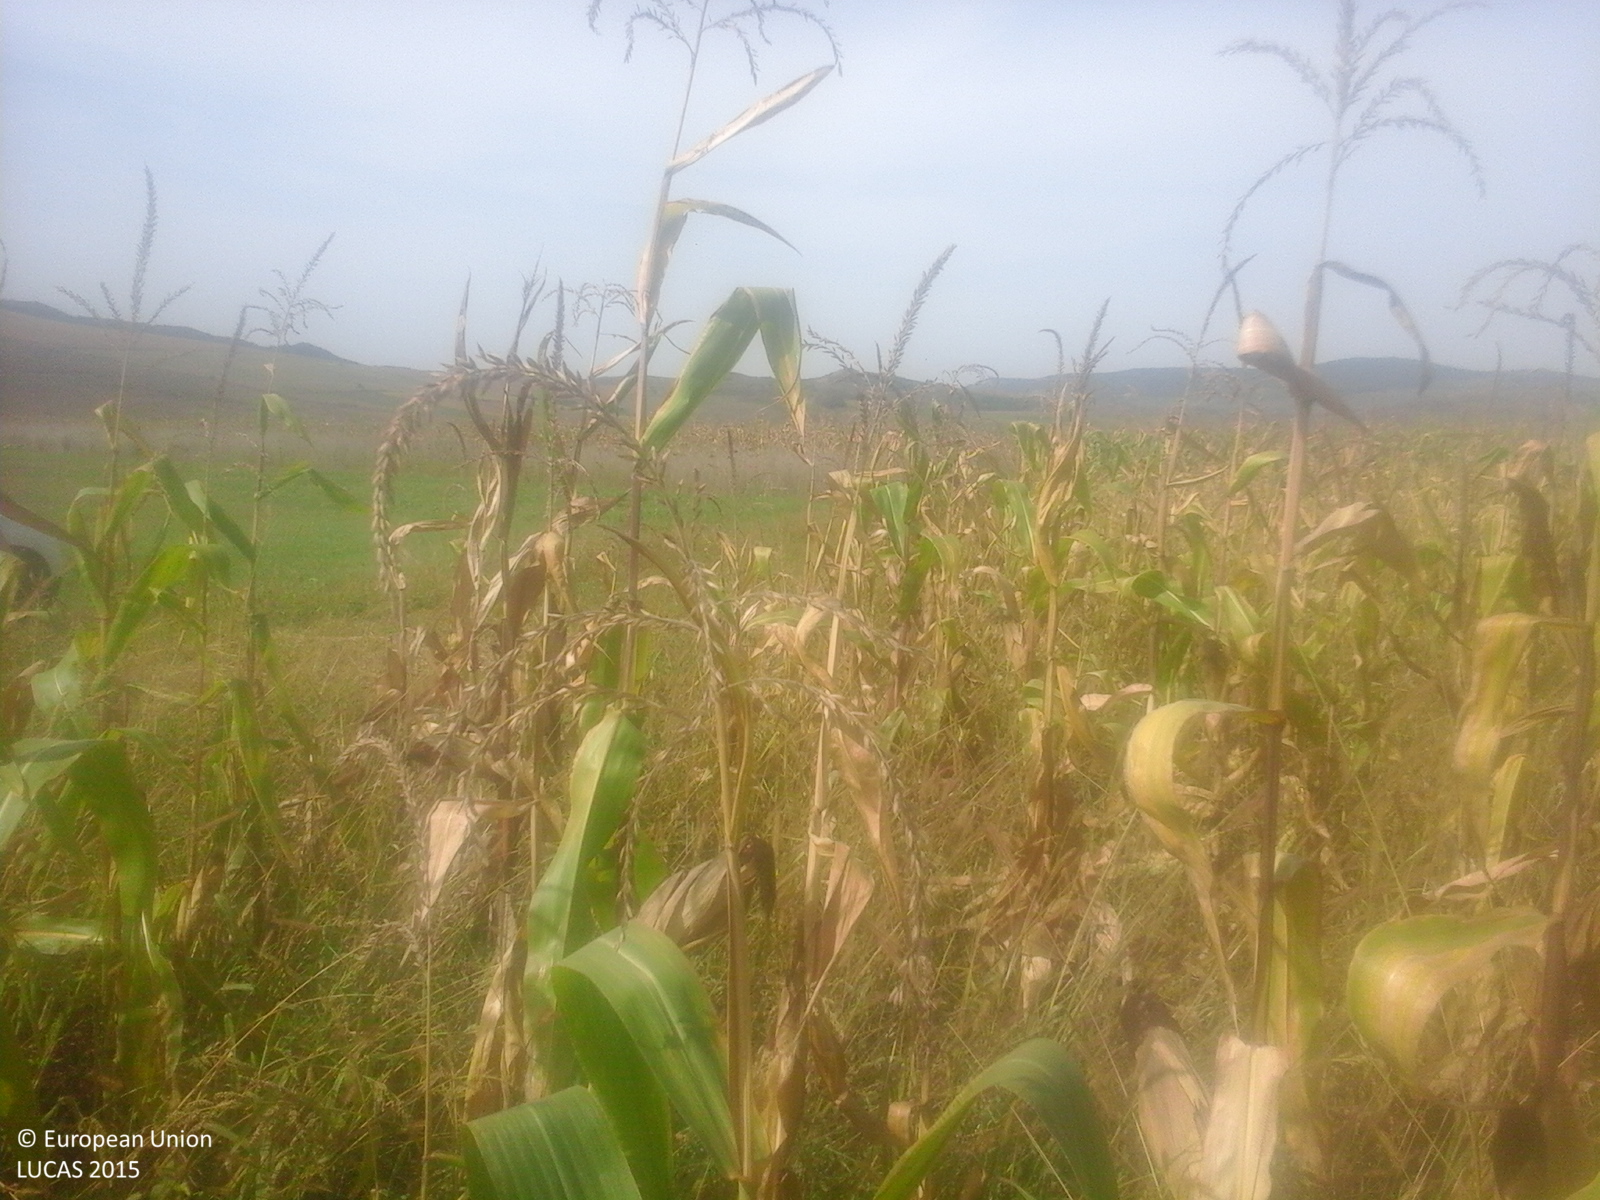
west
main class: Cropland
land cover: Maize
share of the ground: > 75 %
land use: Agriculture (excluding fallow land and kitchen gardens)
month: September
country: RO
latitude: 47.0421
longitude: 24.3410
